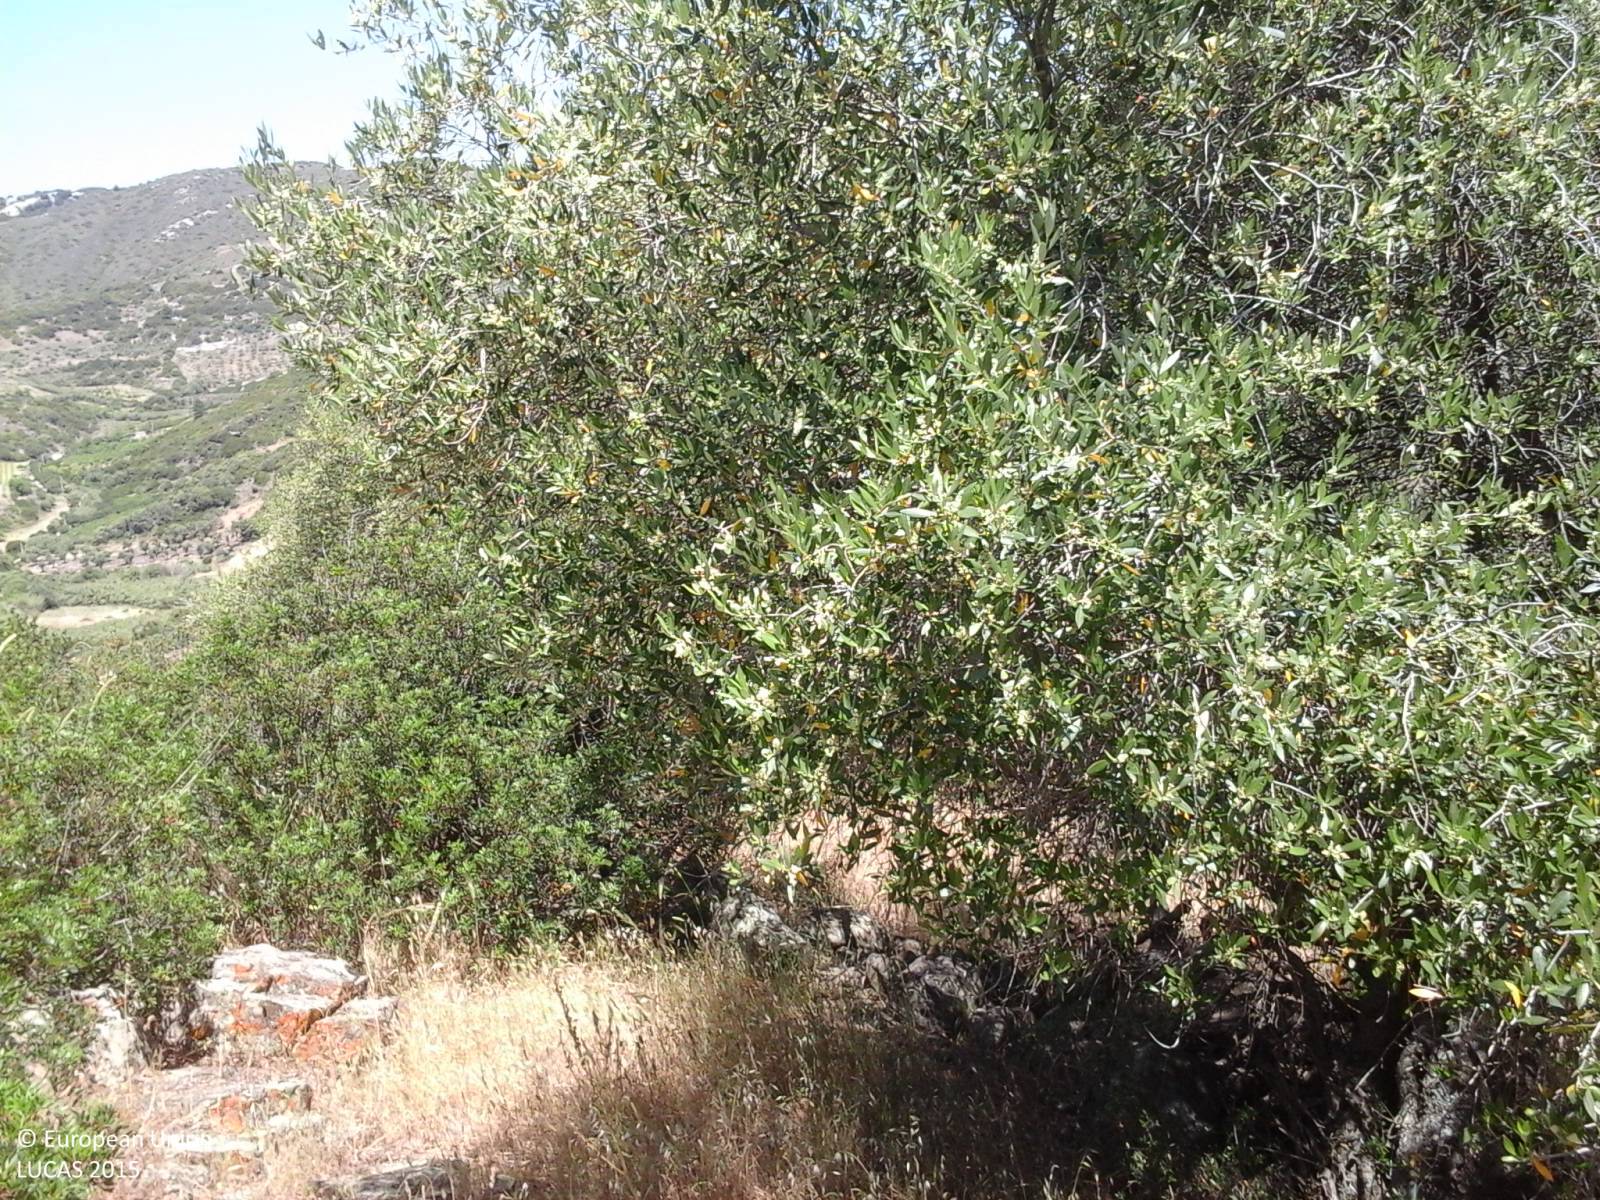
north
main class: Shrubland
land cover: Shrubland with sparse tree cover
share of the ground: > 75 %
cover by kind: shrubs 50 %, herbaceous plants 40 %, broadleaved forest trees 5 %
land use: Semi-natural and natural areas not in use
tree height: < 5 m
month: May
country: IT
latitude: 40.8013
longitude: 8.6670
